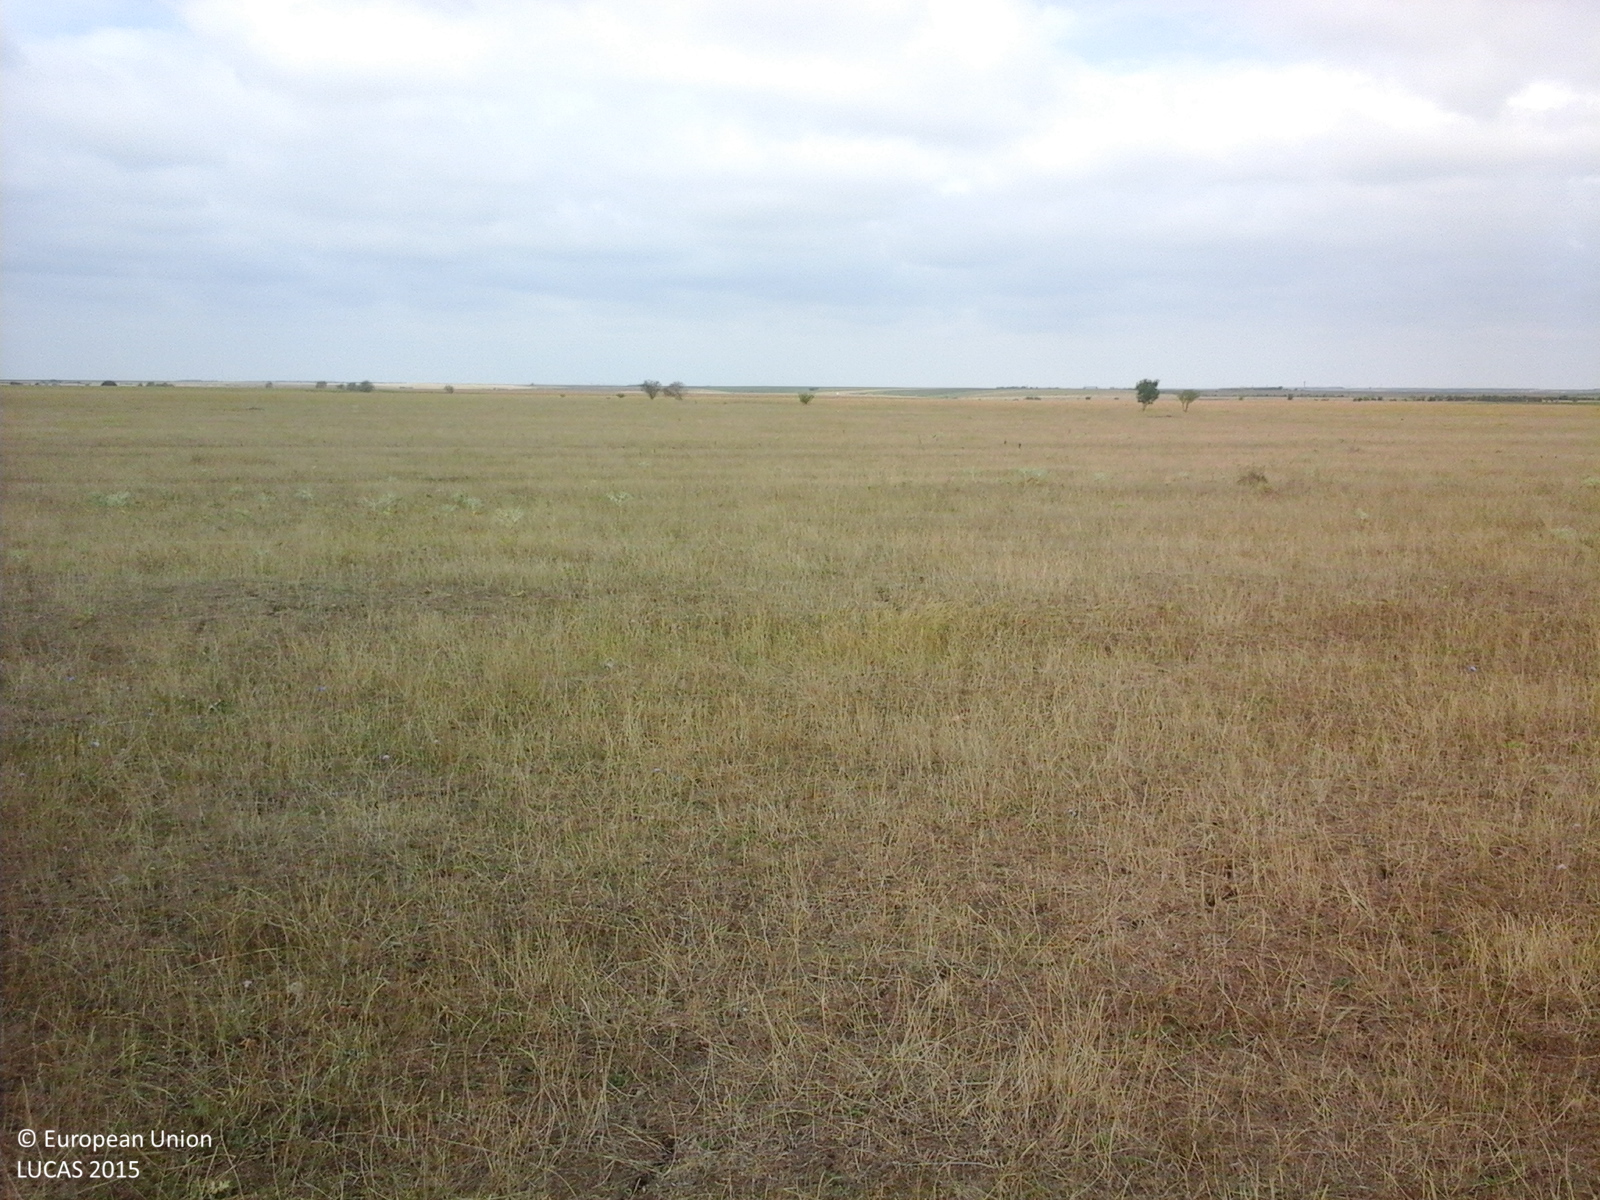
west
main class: Grassland
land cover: Grassland without tree/shrub cover
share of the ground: > 75 %
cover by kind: herbaceous plants 100 %
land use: Agriculture (excluding fallow land and kitchen gardens)
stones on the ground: < 10 %
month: August
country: RO
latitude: 45.4023
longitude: 21.4913
